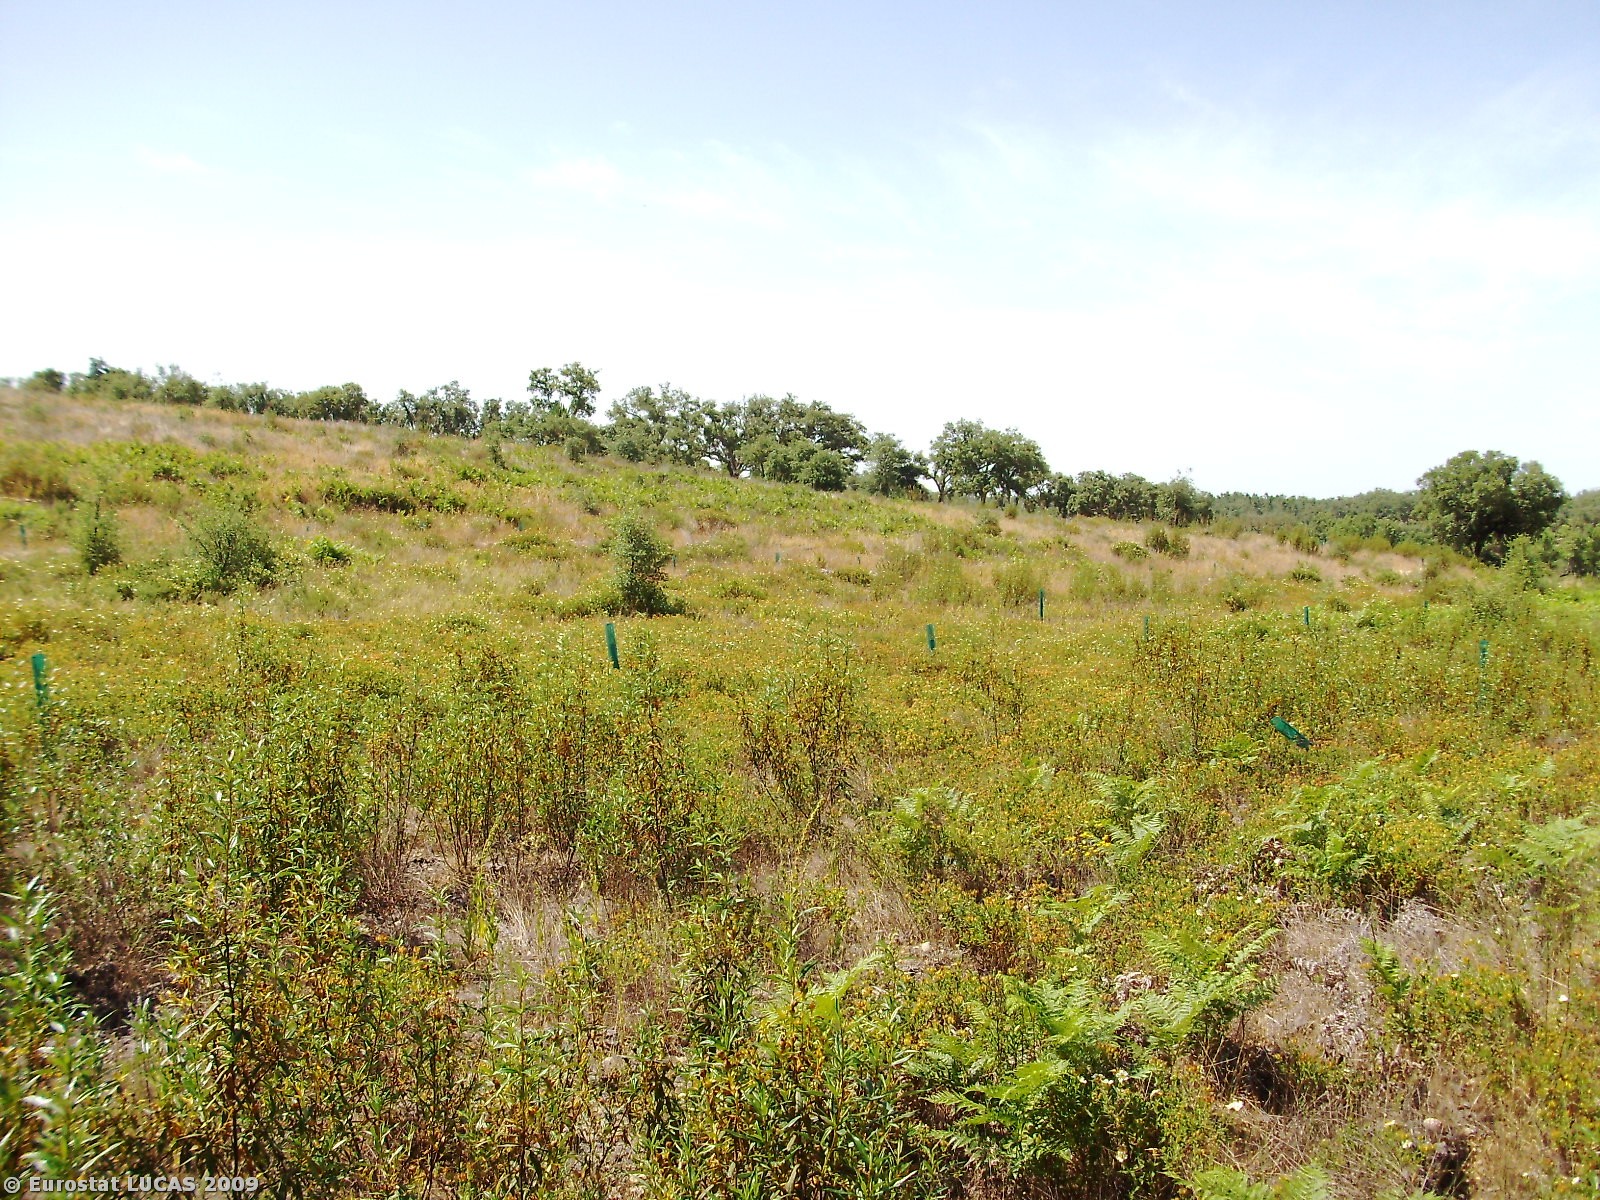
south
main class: Woodland
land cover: Broadleaved woodland
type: broadleaved evergreen forest
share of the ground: 25 - 50 %
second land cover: Shrubland with sparse tree cover
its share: 50 - 75 %
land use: Forestry
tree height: > 5 m
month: June
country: PT
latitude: 39.3866
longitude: -7.8755
